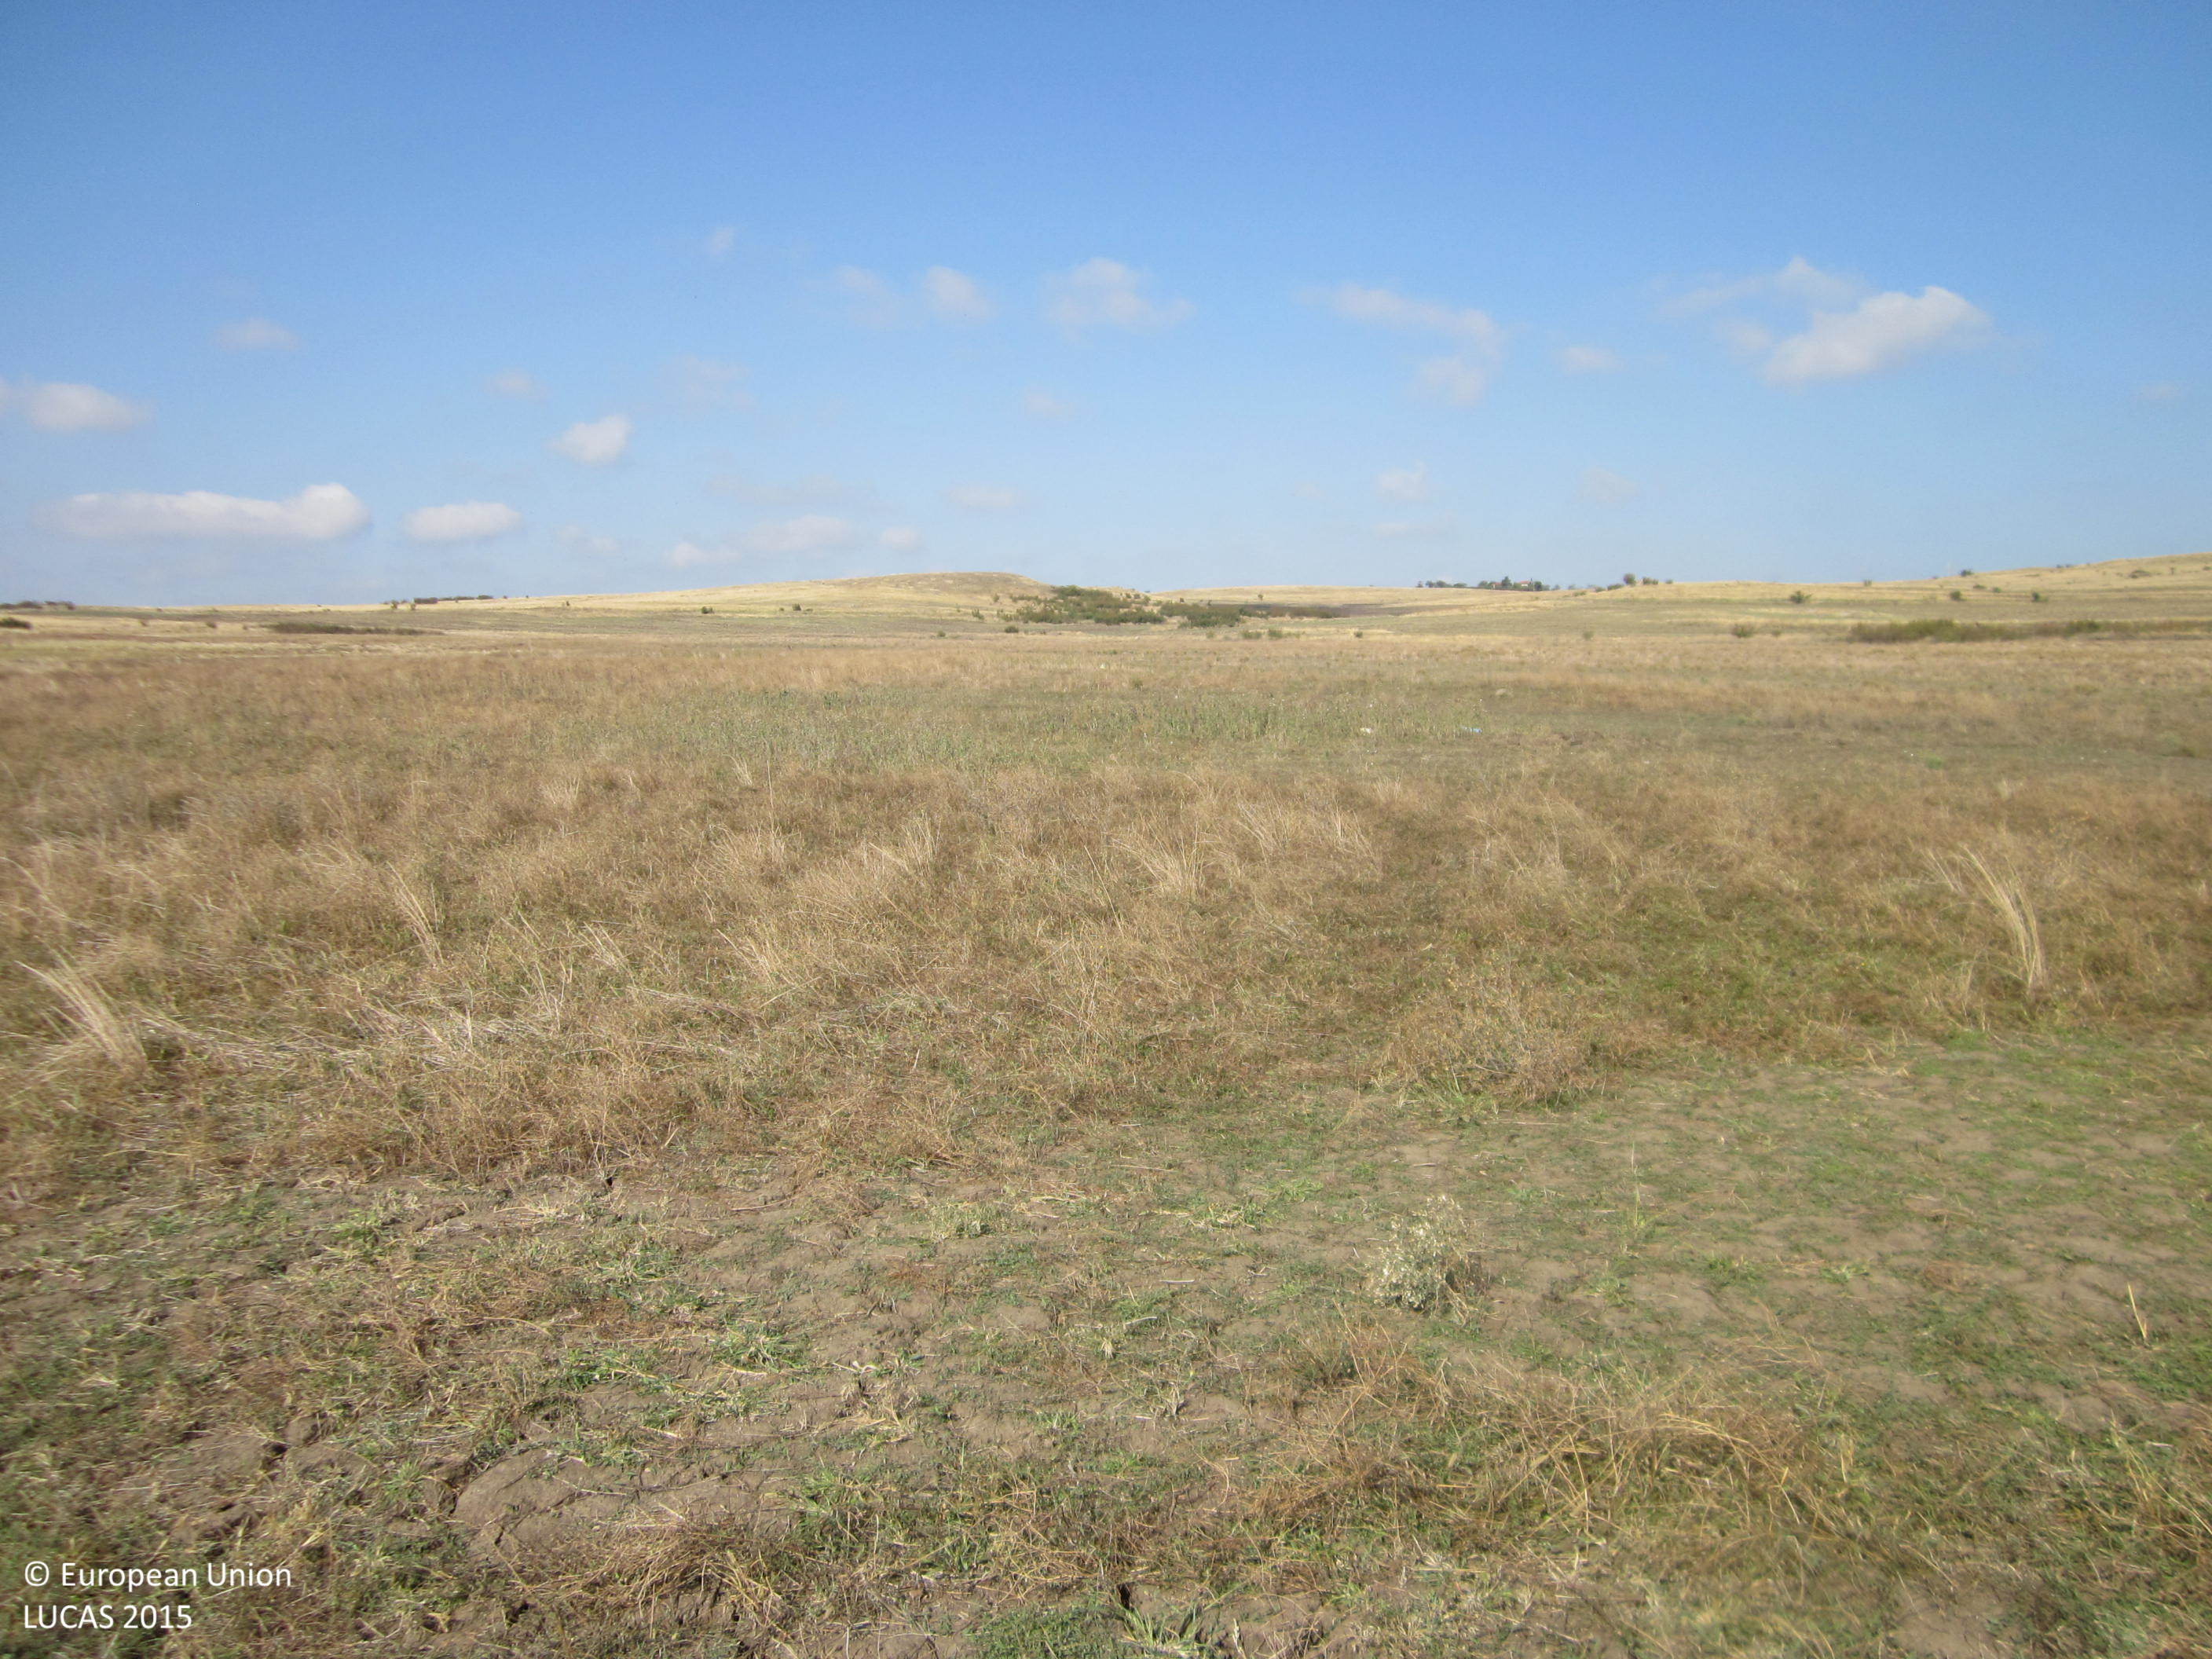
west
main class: Grassland
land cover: Grassland without tree/shrub cover
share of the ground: > 75 %
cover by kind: herbaceous plants 80 %, unconsolidated bare surface 20 %
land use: Agriculture (excluding fallow land and kitchen gardens)
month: September
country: BG
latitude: 42.6155
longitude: 27.4663
